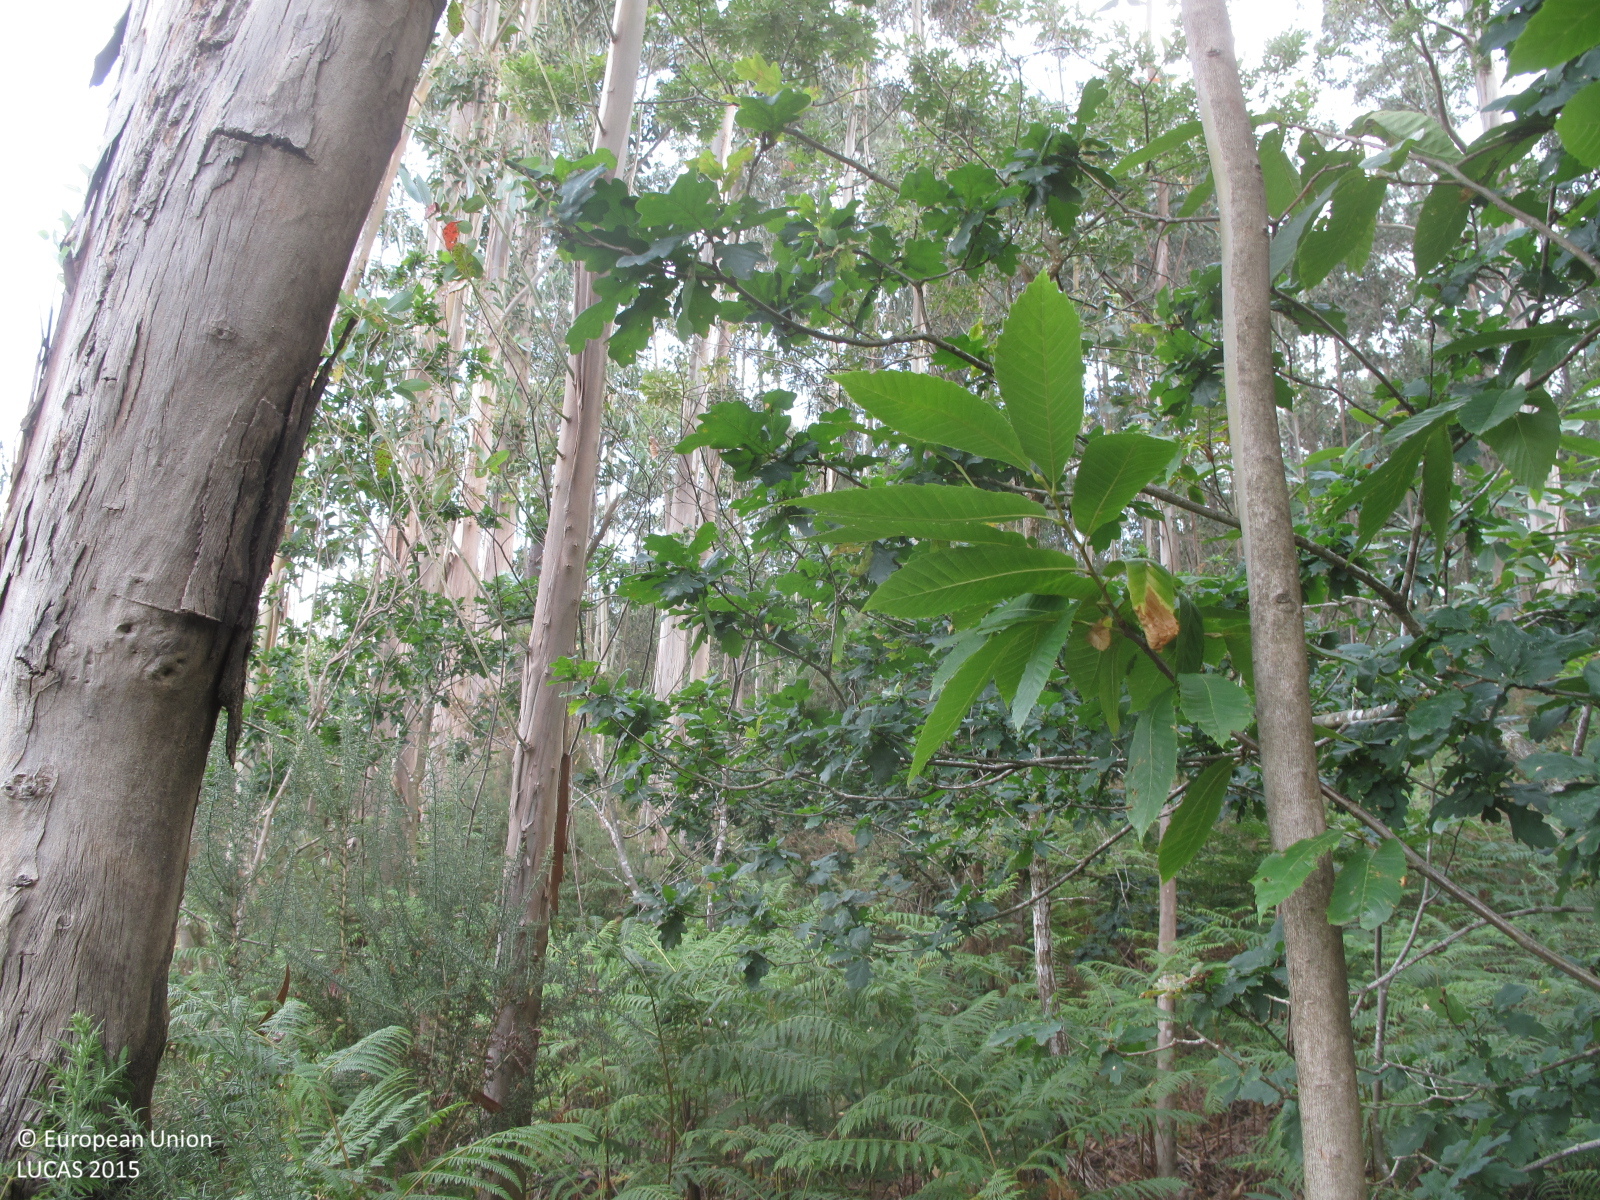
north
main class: Woodland
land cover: Broadleaved woodland
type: exotic forest
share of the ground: 50 - 75 %
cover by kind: broadleaved forest trees 60 %, shrubs 20 %, herbaceous plants 20 %
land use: Forestry
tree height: > 5 m
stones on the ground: 10 - 25 %
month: July
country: ES
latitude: 43.3257
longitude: -8.2417
